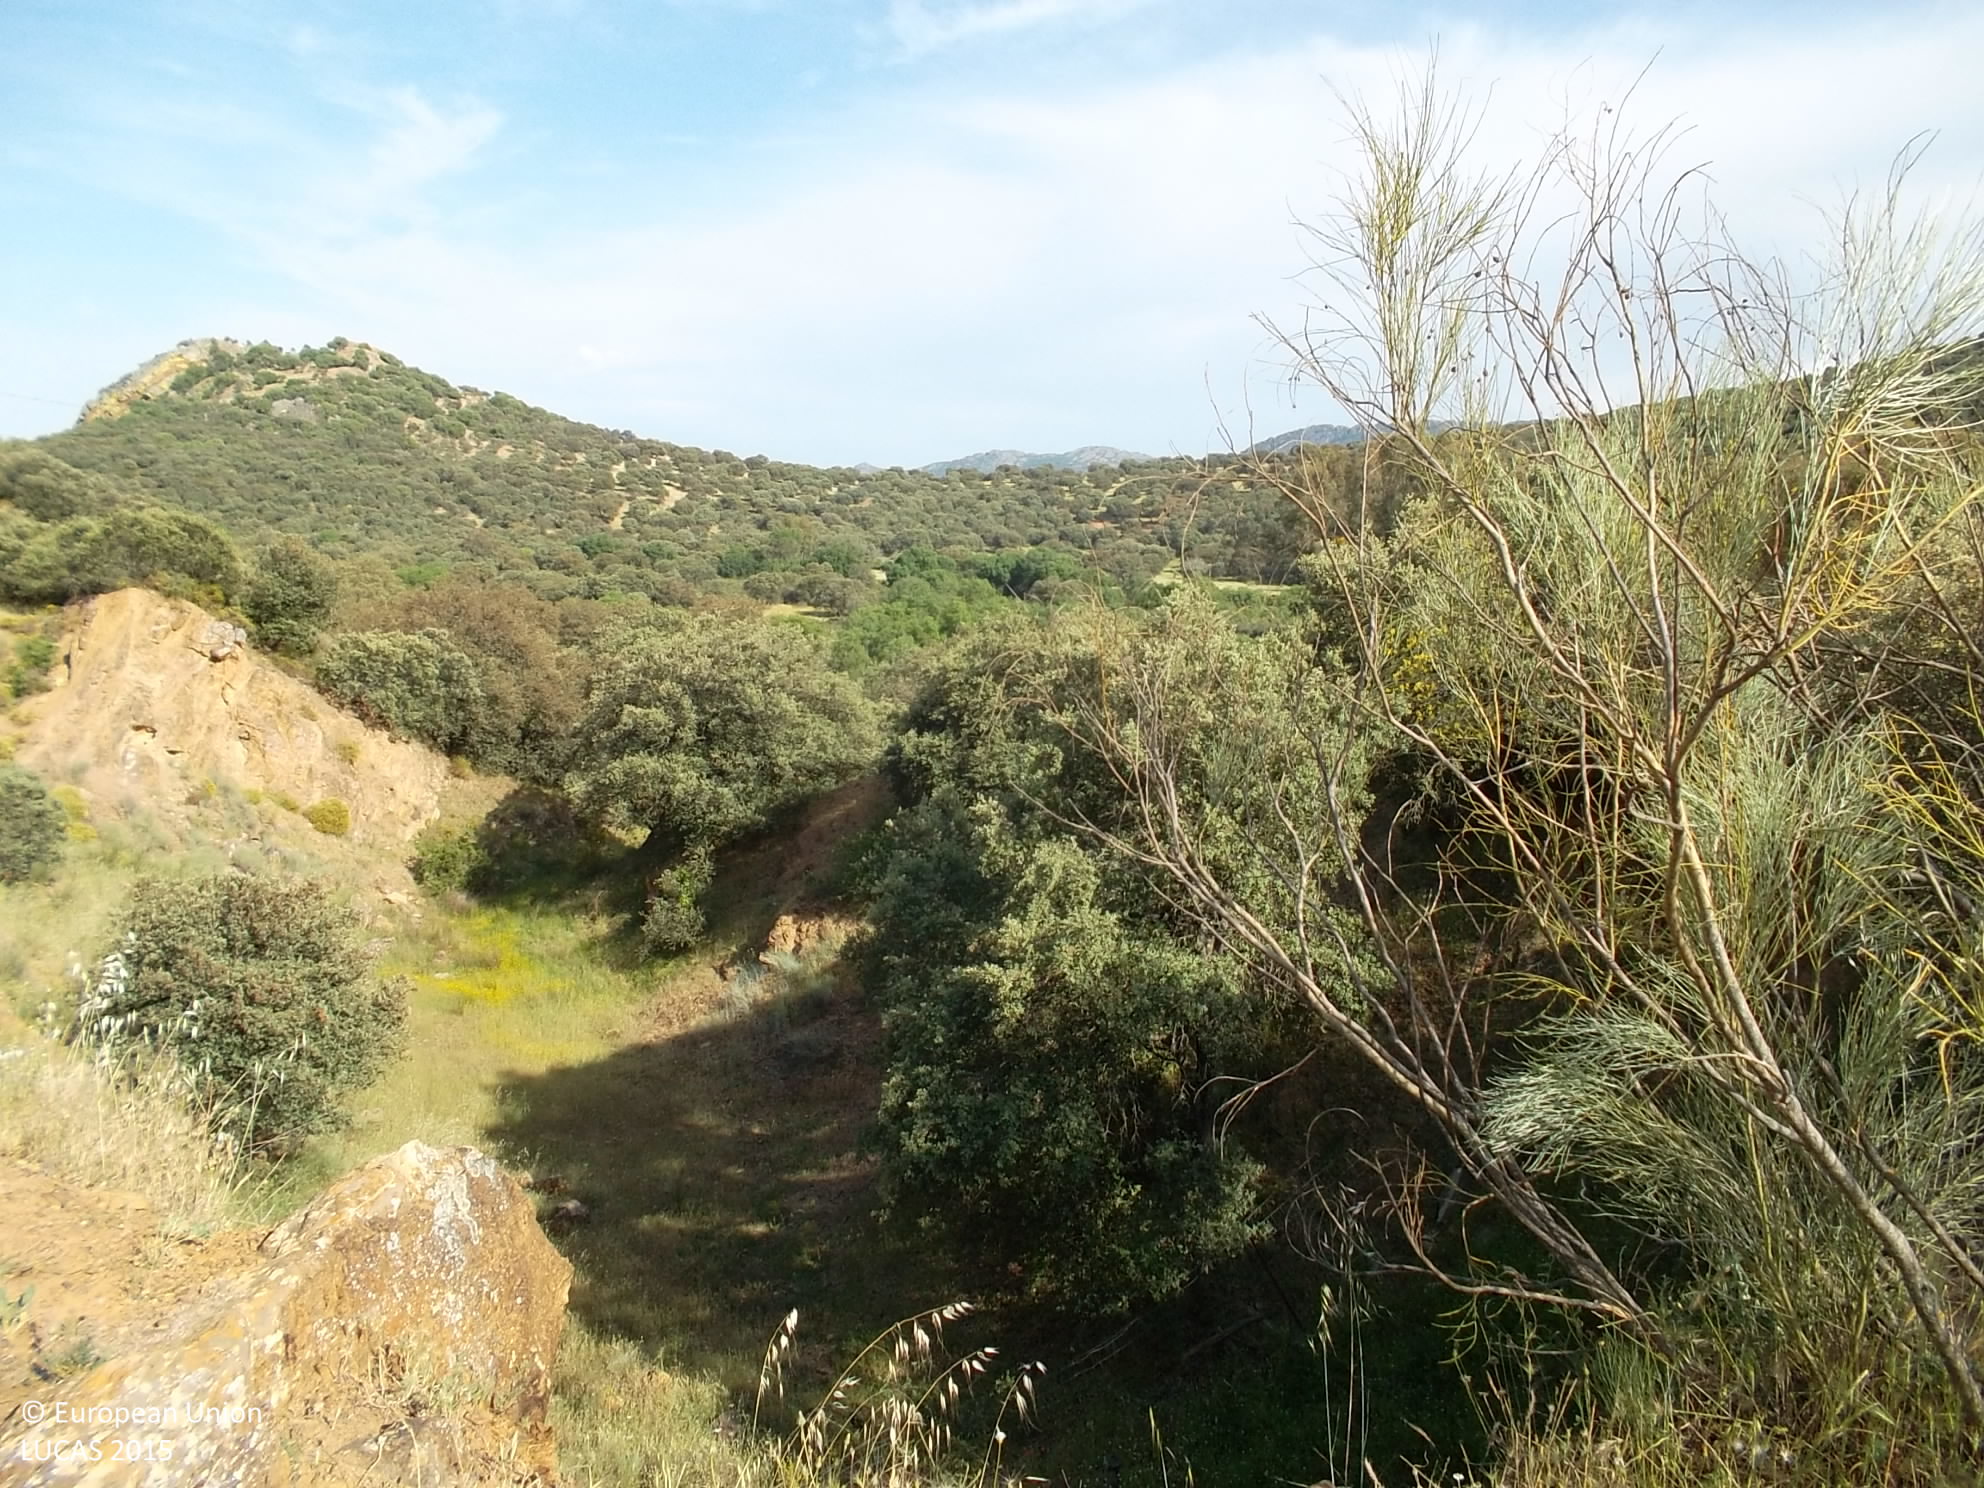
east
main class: Shrubland
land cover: Shrubland with sparse tree cover
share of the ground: 10 - 25 %
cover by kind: herbaceous plants 85 %, shrubs 10 %, broadleaved forest trees 5 %
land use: Agriculture (excluding fallow land and kitchen gardens)
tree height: > 5 m
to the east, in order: Shrubland with sparse tree cover; Fences; Broadleaved woodland; Tracks; Broadleaved woodland; Fences; Broadleaved woodland
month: May
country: ES
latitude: 38.7605
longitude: -4.7468
